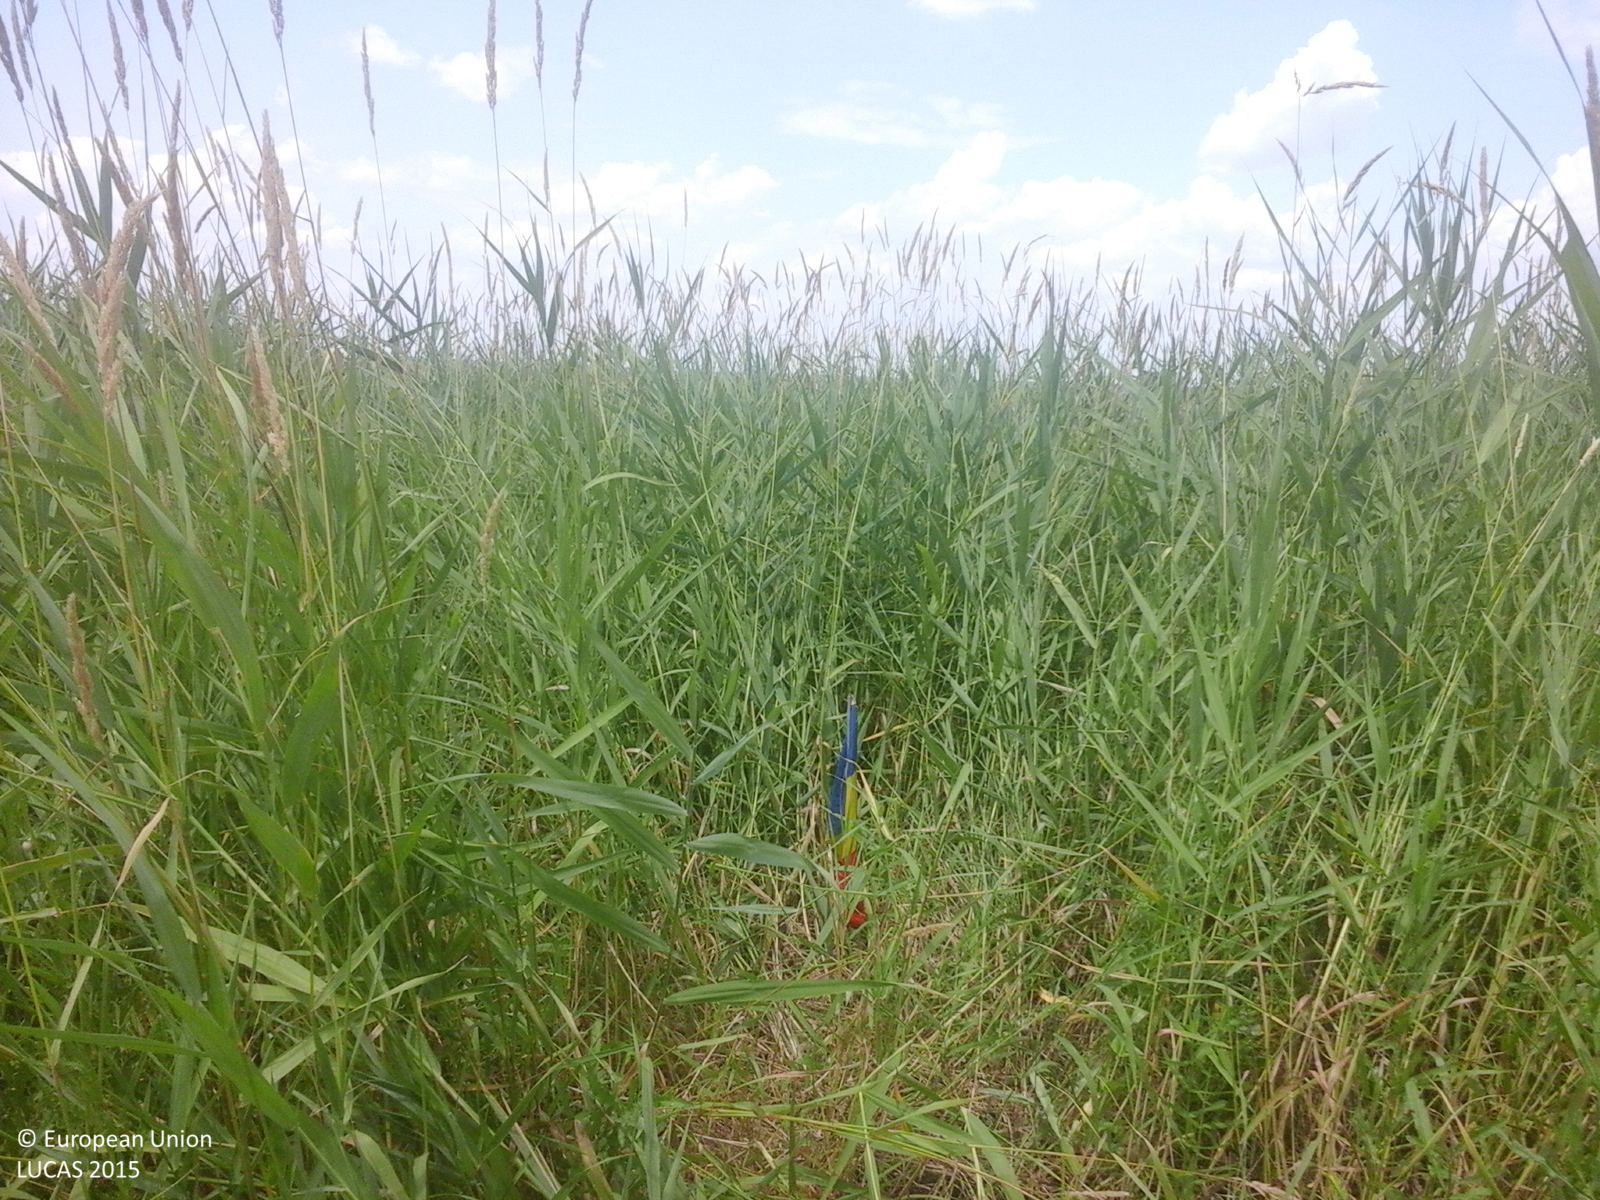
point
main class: Grassland
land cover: Spontaneously vegetated surfaces
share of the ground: > 75 %
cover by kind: herbaceous plants 100 %
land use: Fallow land
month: June
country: RO
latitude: 44.0617
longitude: 26.5279
